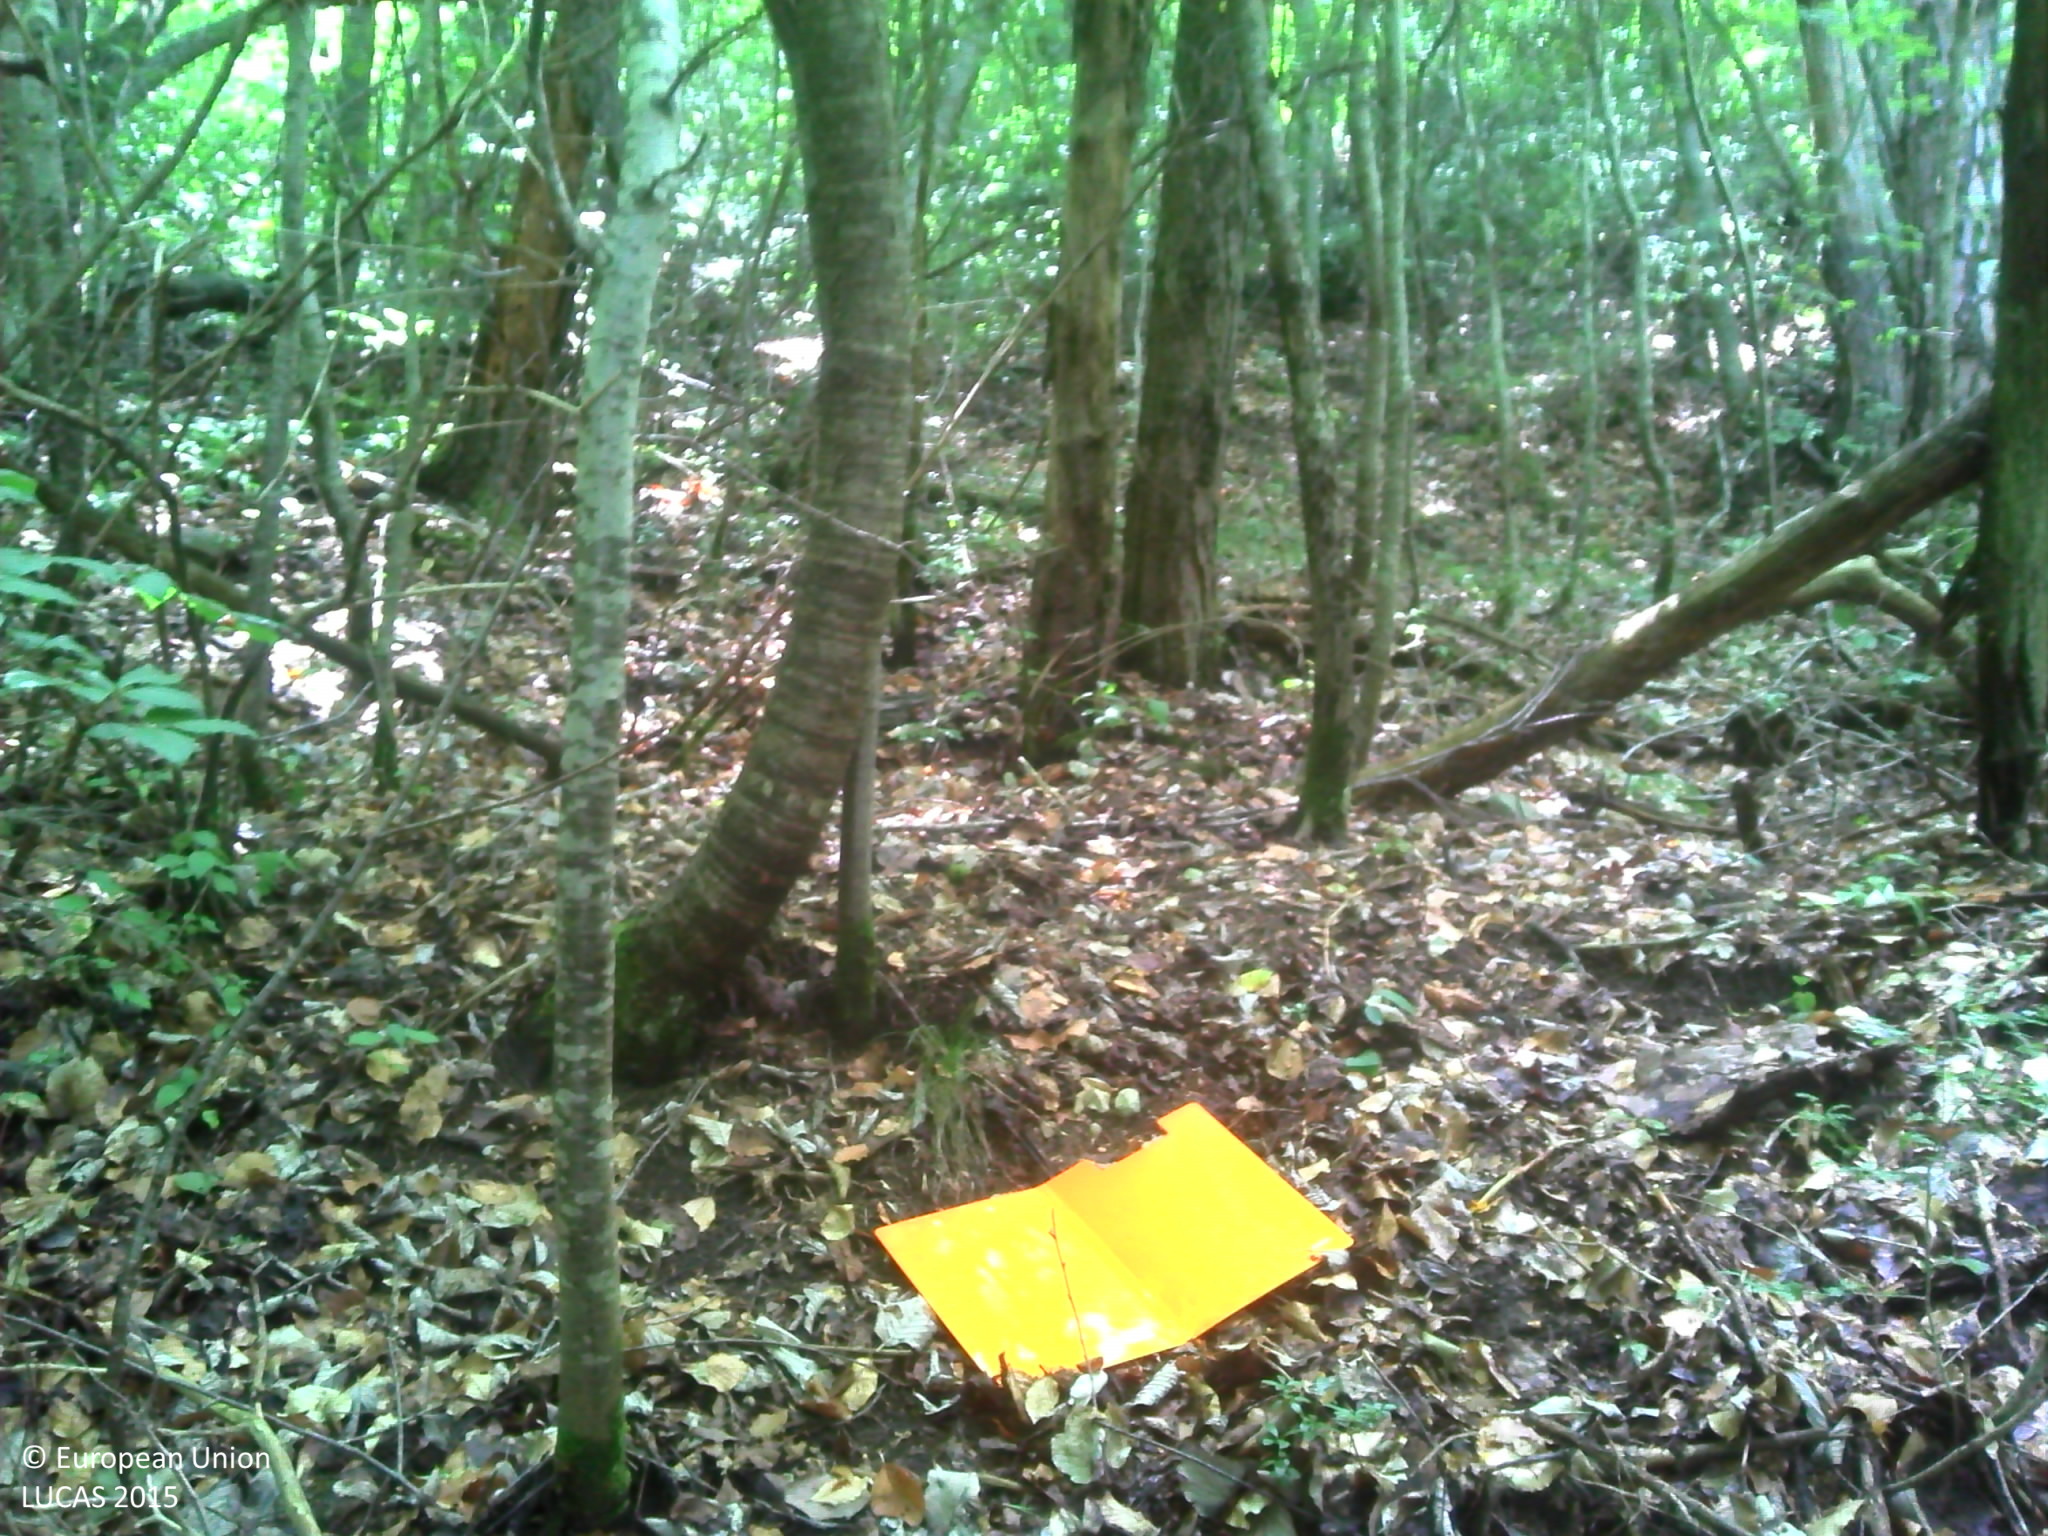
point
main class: Woodland
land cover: Spruce dominated mixed woodland
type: coniferous forest of the mediterranean region
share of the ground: > 75 %
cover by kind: coniferous forest trees 50 %, broadleaved forest trees 35 %, shrubs 10 %, herbaceous plants 5 %
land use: Forestry
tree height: > 5 m
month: July
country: FR
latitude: 44.5029
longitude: 6.3465
